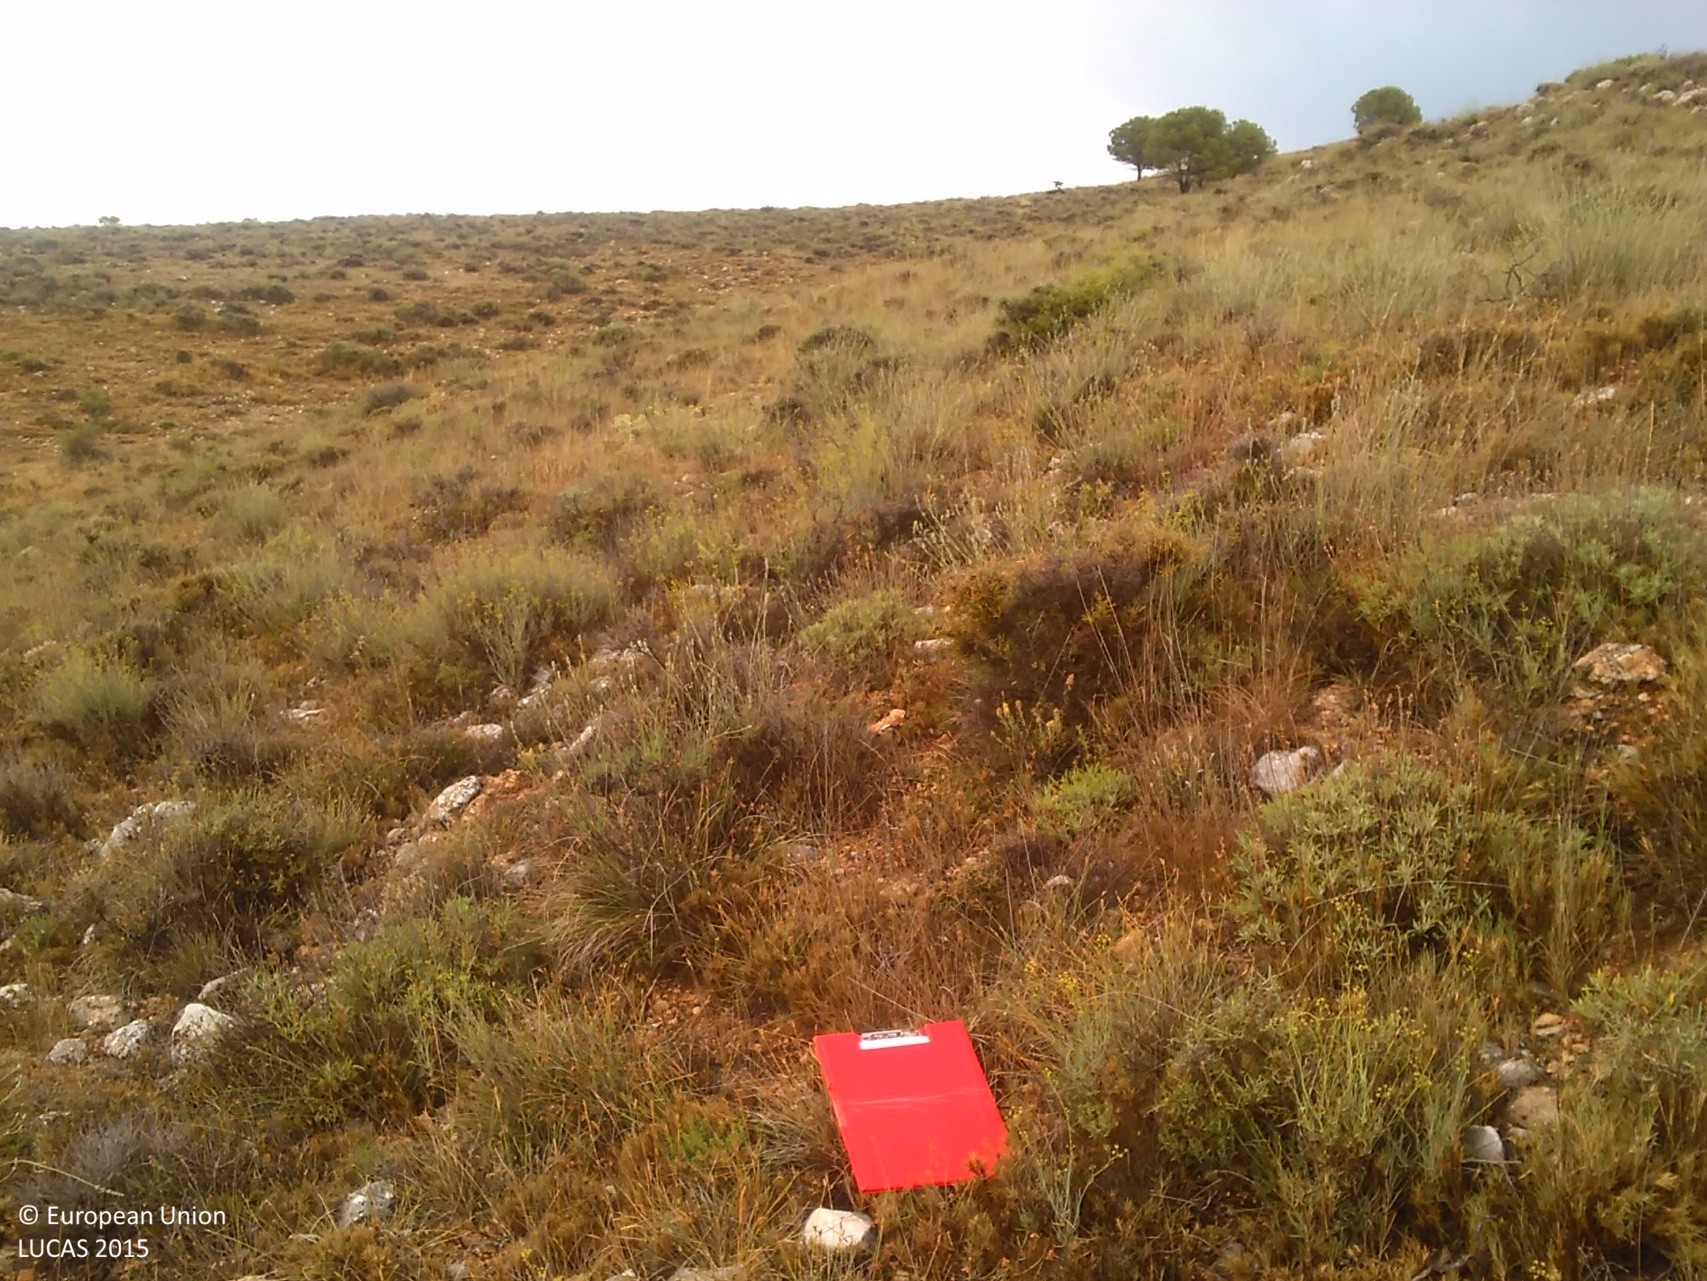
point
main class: Shrubland
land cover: Shrubland without tree cover
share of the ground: 50 - 75 %
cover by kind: shrubs 60 %, herbaceous plants 20 %, unconsolidated bare surface 20 %
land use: Semi-natural and natural areas not in use
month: July
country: ES
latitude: 41.4440
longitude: -2.0109
